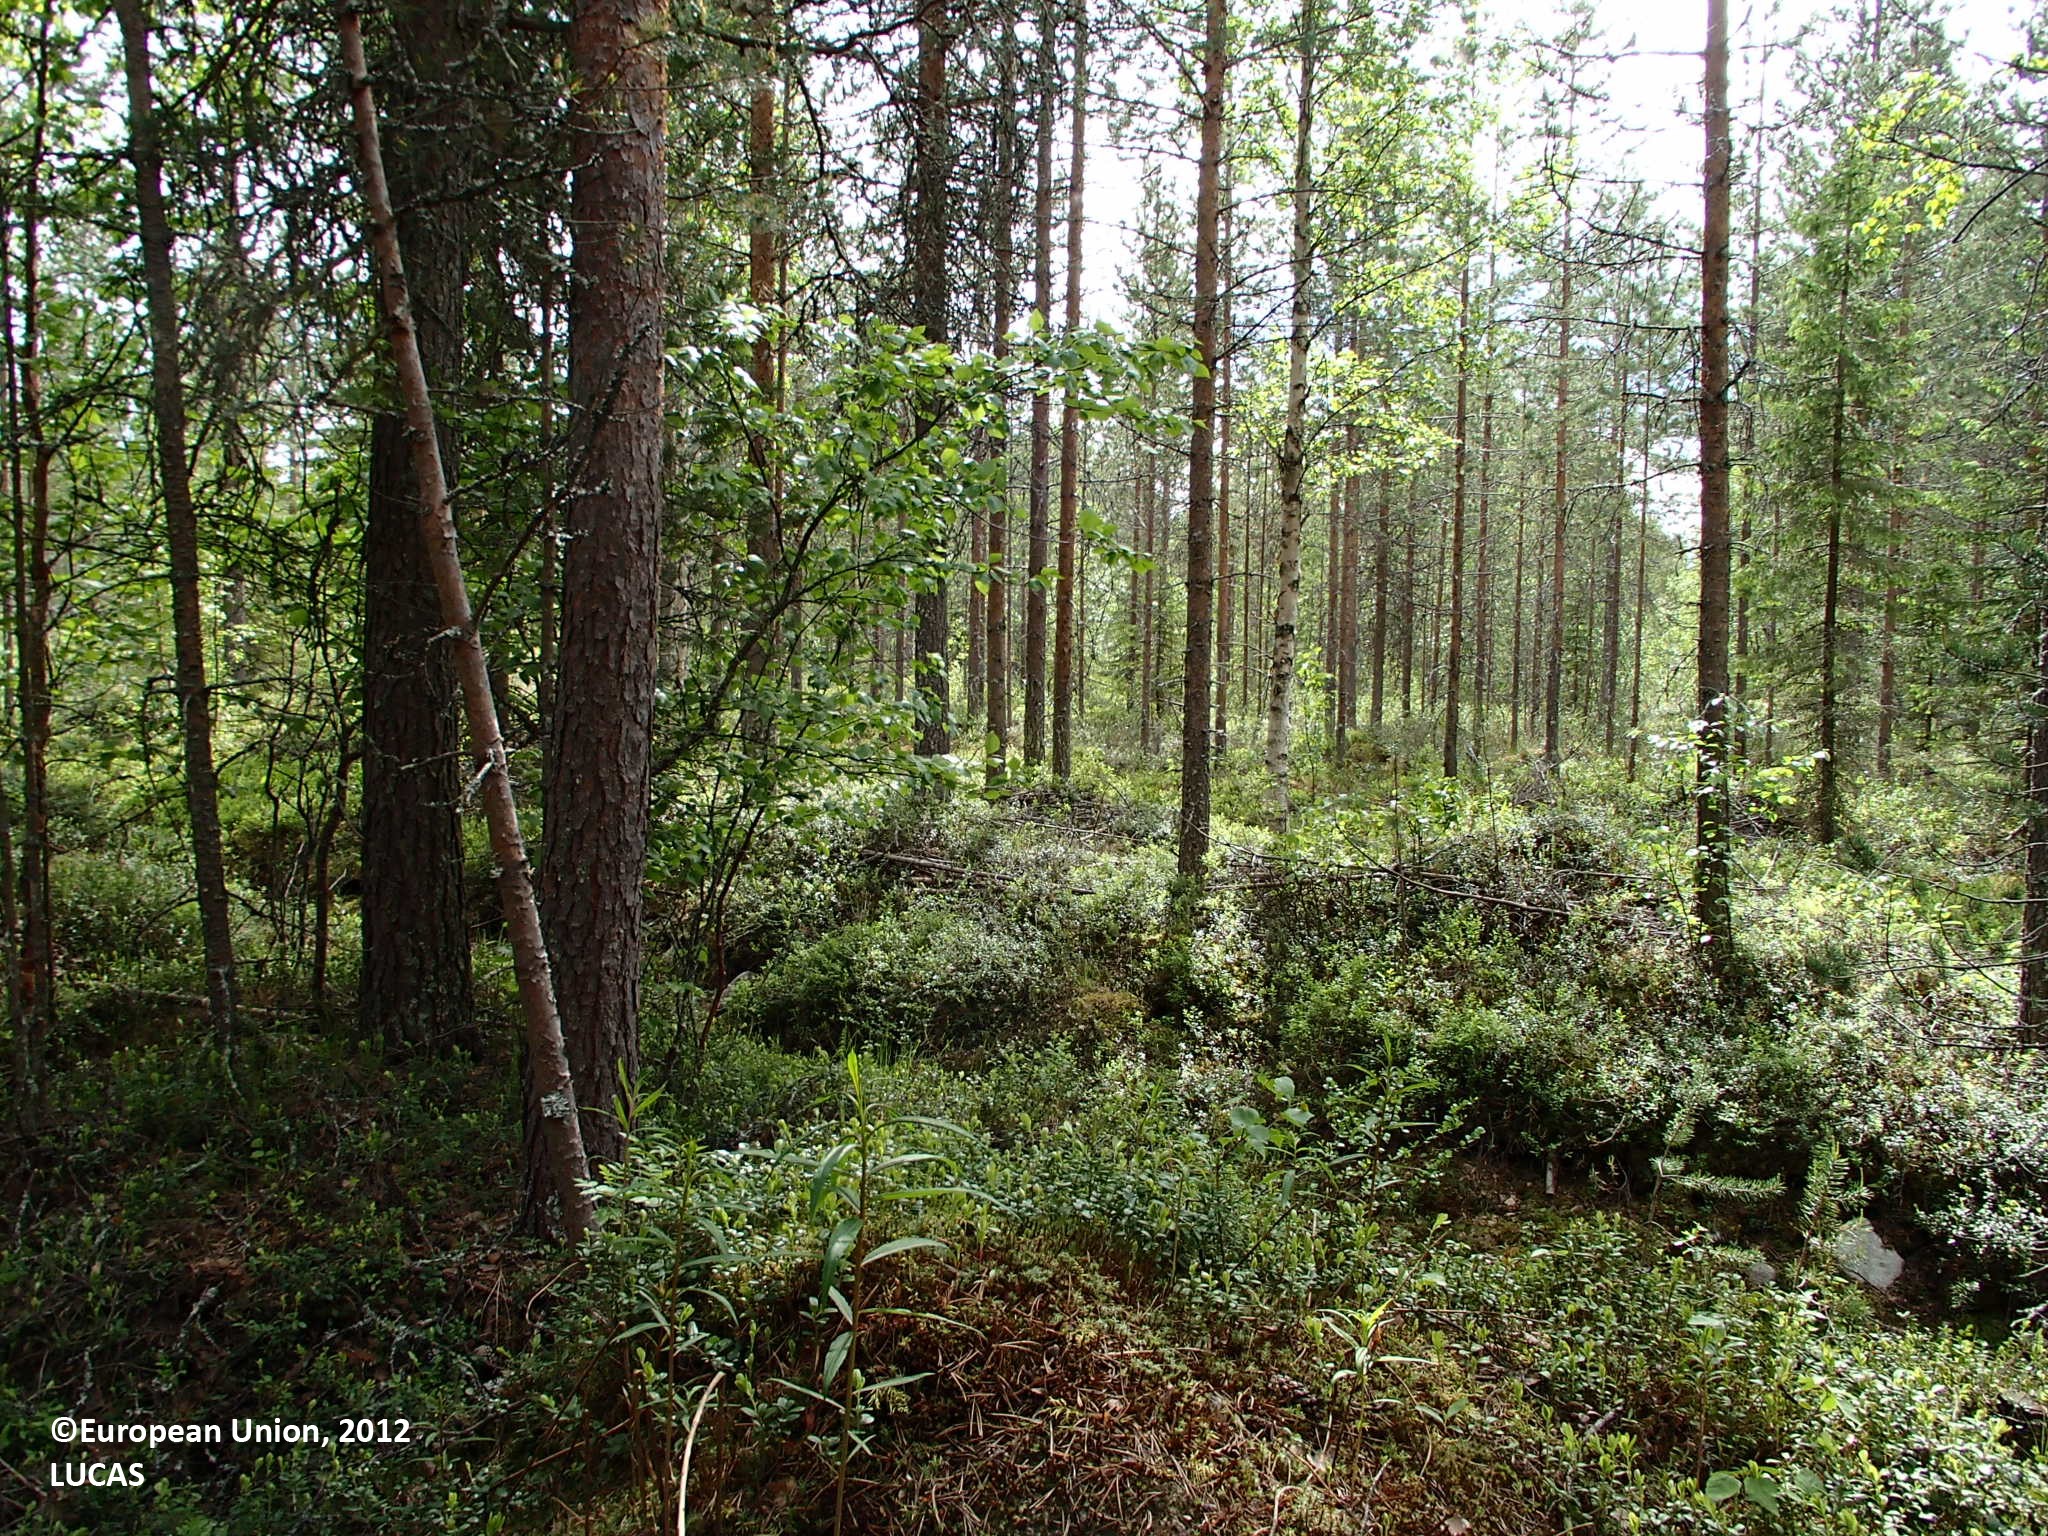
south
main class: Woodland
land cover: Pine dominated coniferous woodland
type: boreal forest
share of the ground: > 75 %
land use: Forestry
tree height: > 5 m
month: June
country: FI
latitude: 66.6041
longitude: 26.3535
